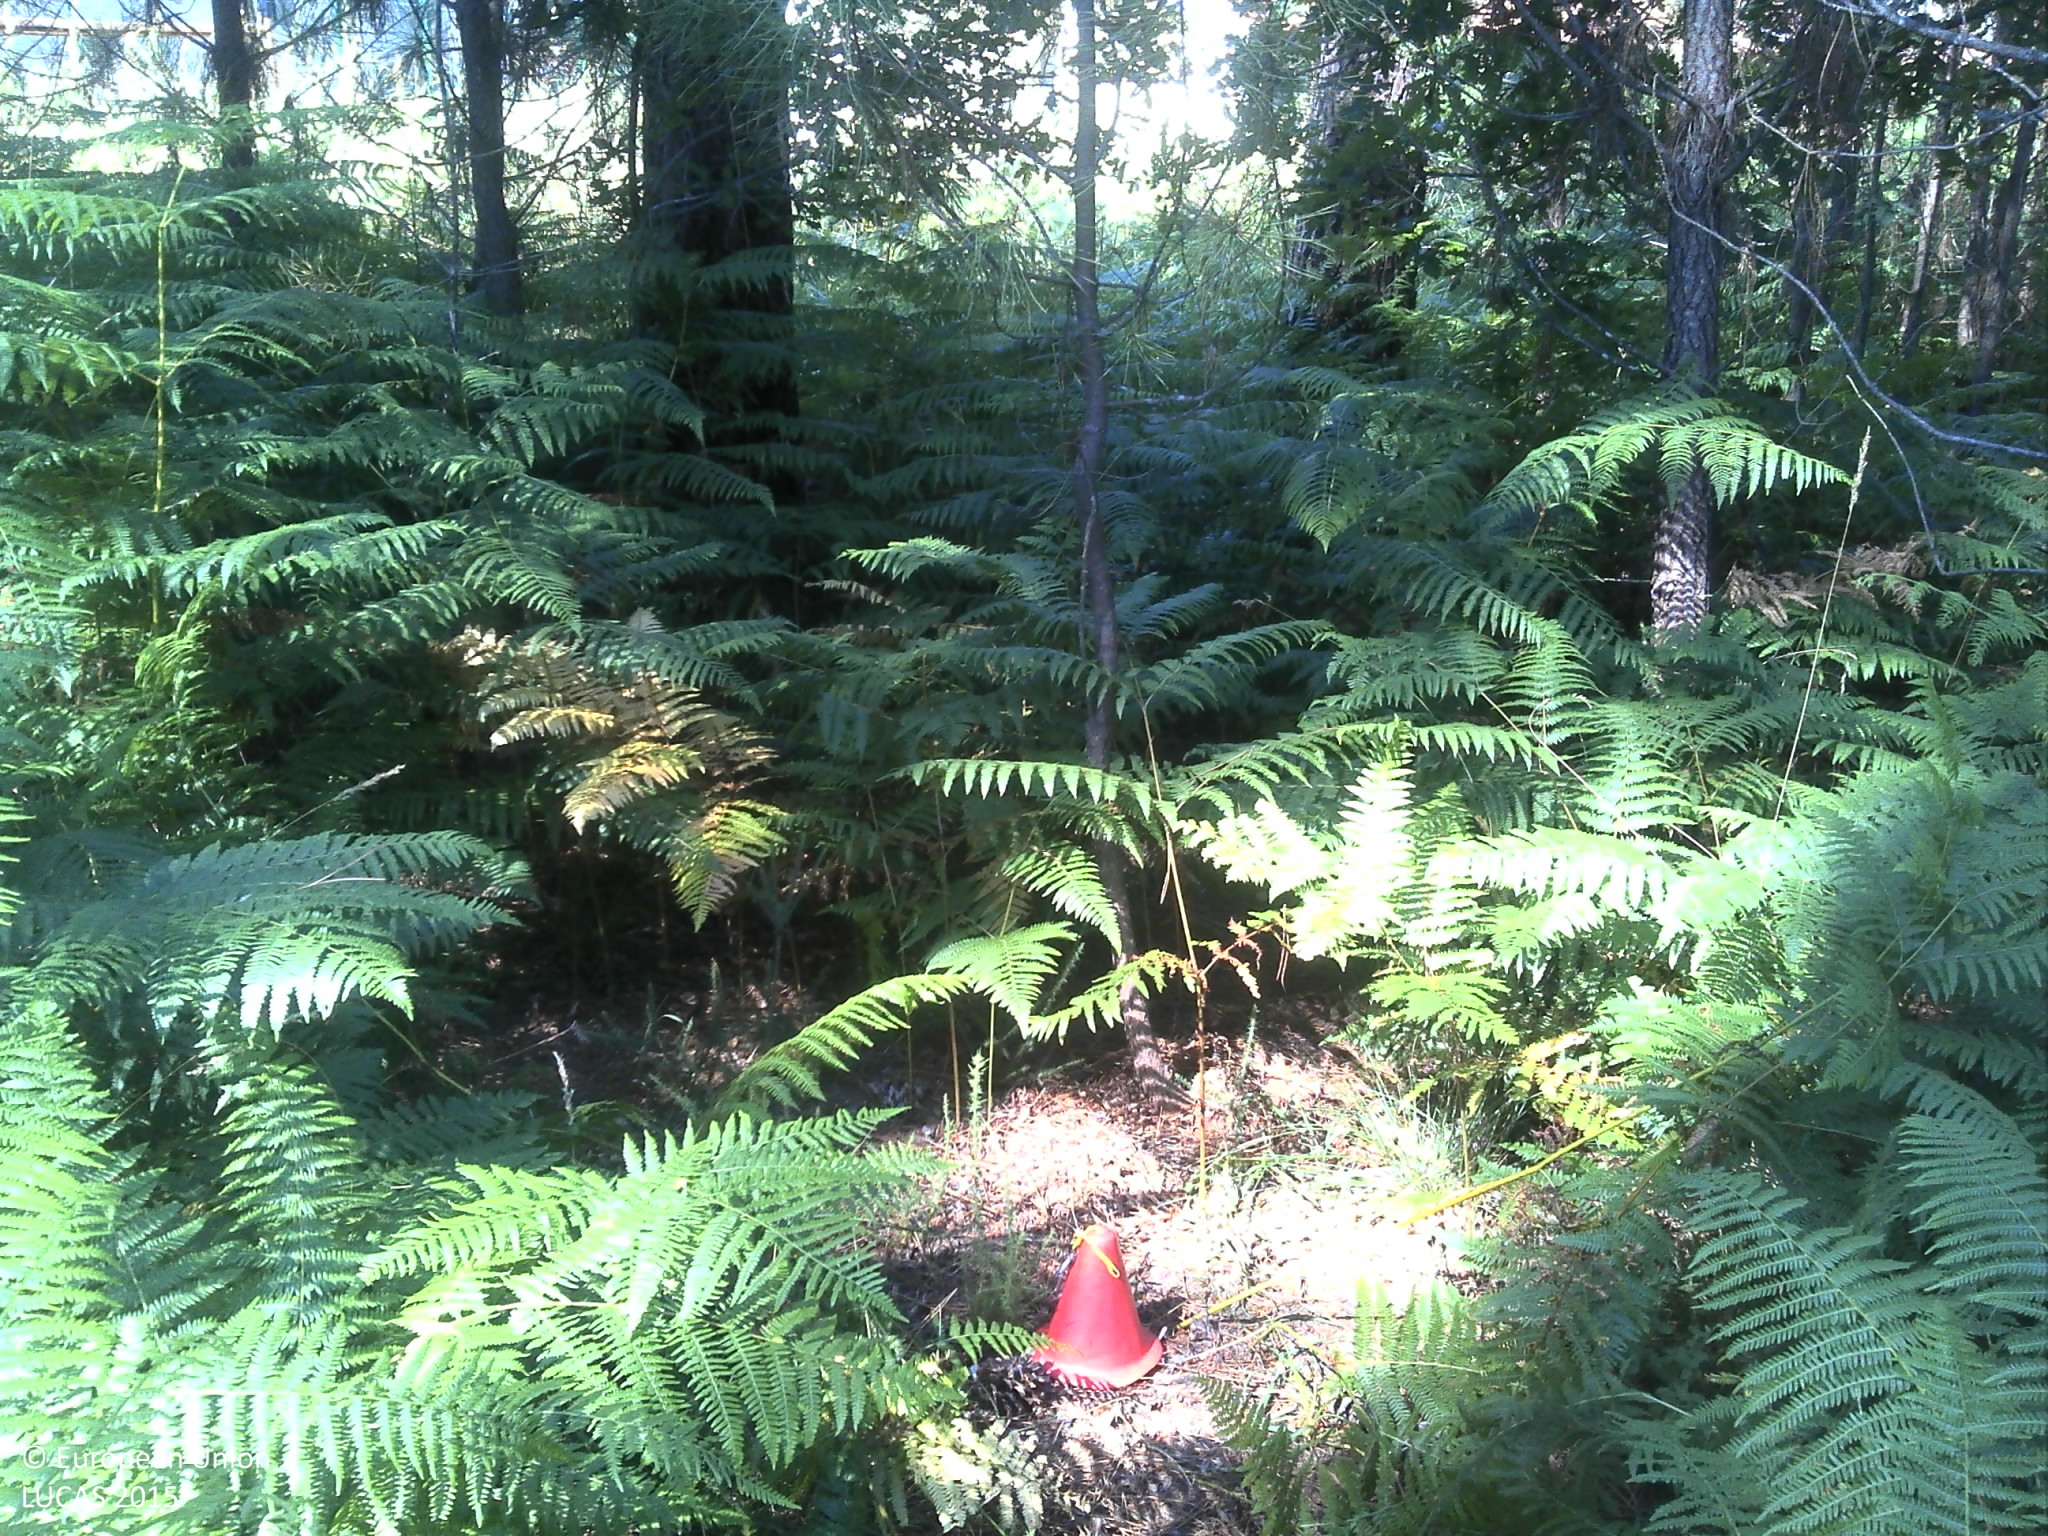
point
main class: Woodland
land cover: Pine dominated coniferous woodland
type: coniferous forest of the mediterranean region
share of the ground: 50 - 75 %
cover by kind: coniferous forest trees 65 %, shrubs 30 %, unconsolidated bare surface 5 %
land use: Forestry
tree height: > 5 m
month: June
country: PT
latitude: 41.3917
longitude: -8.1176
